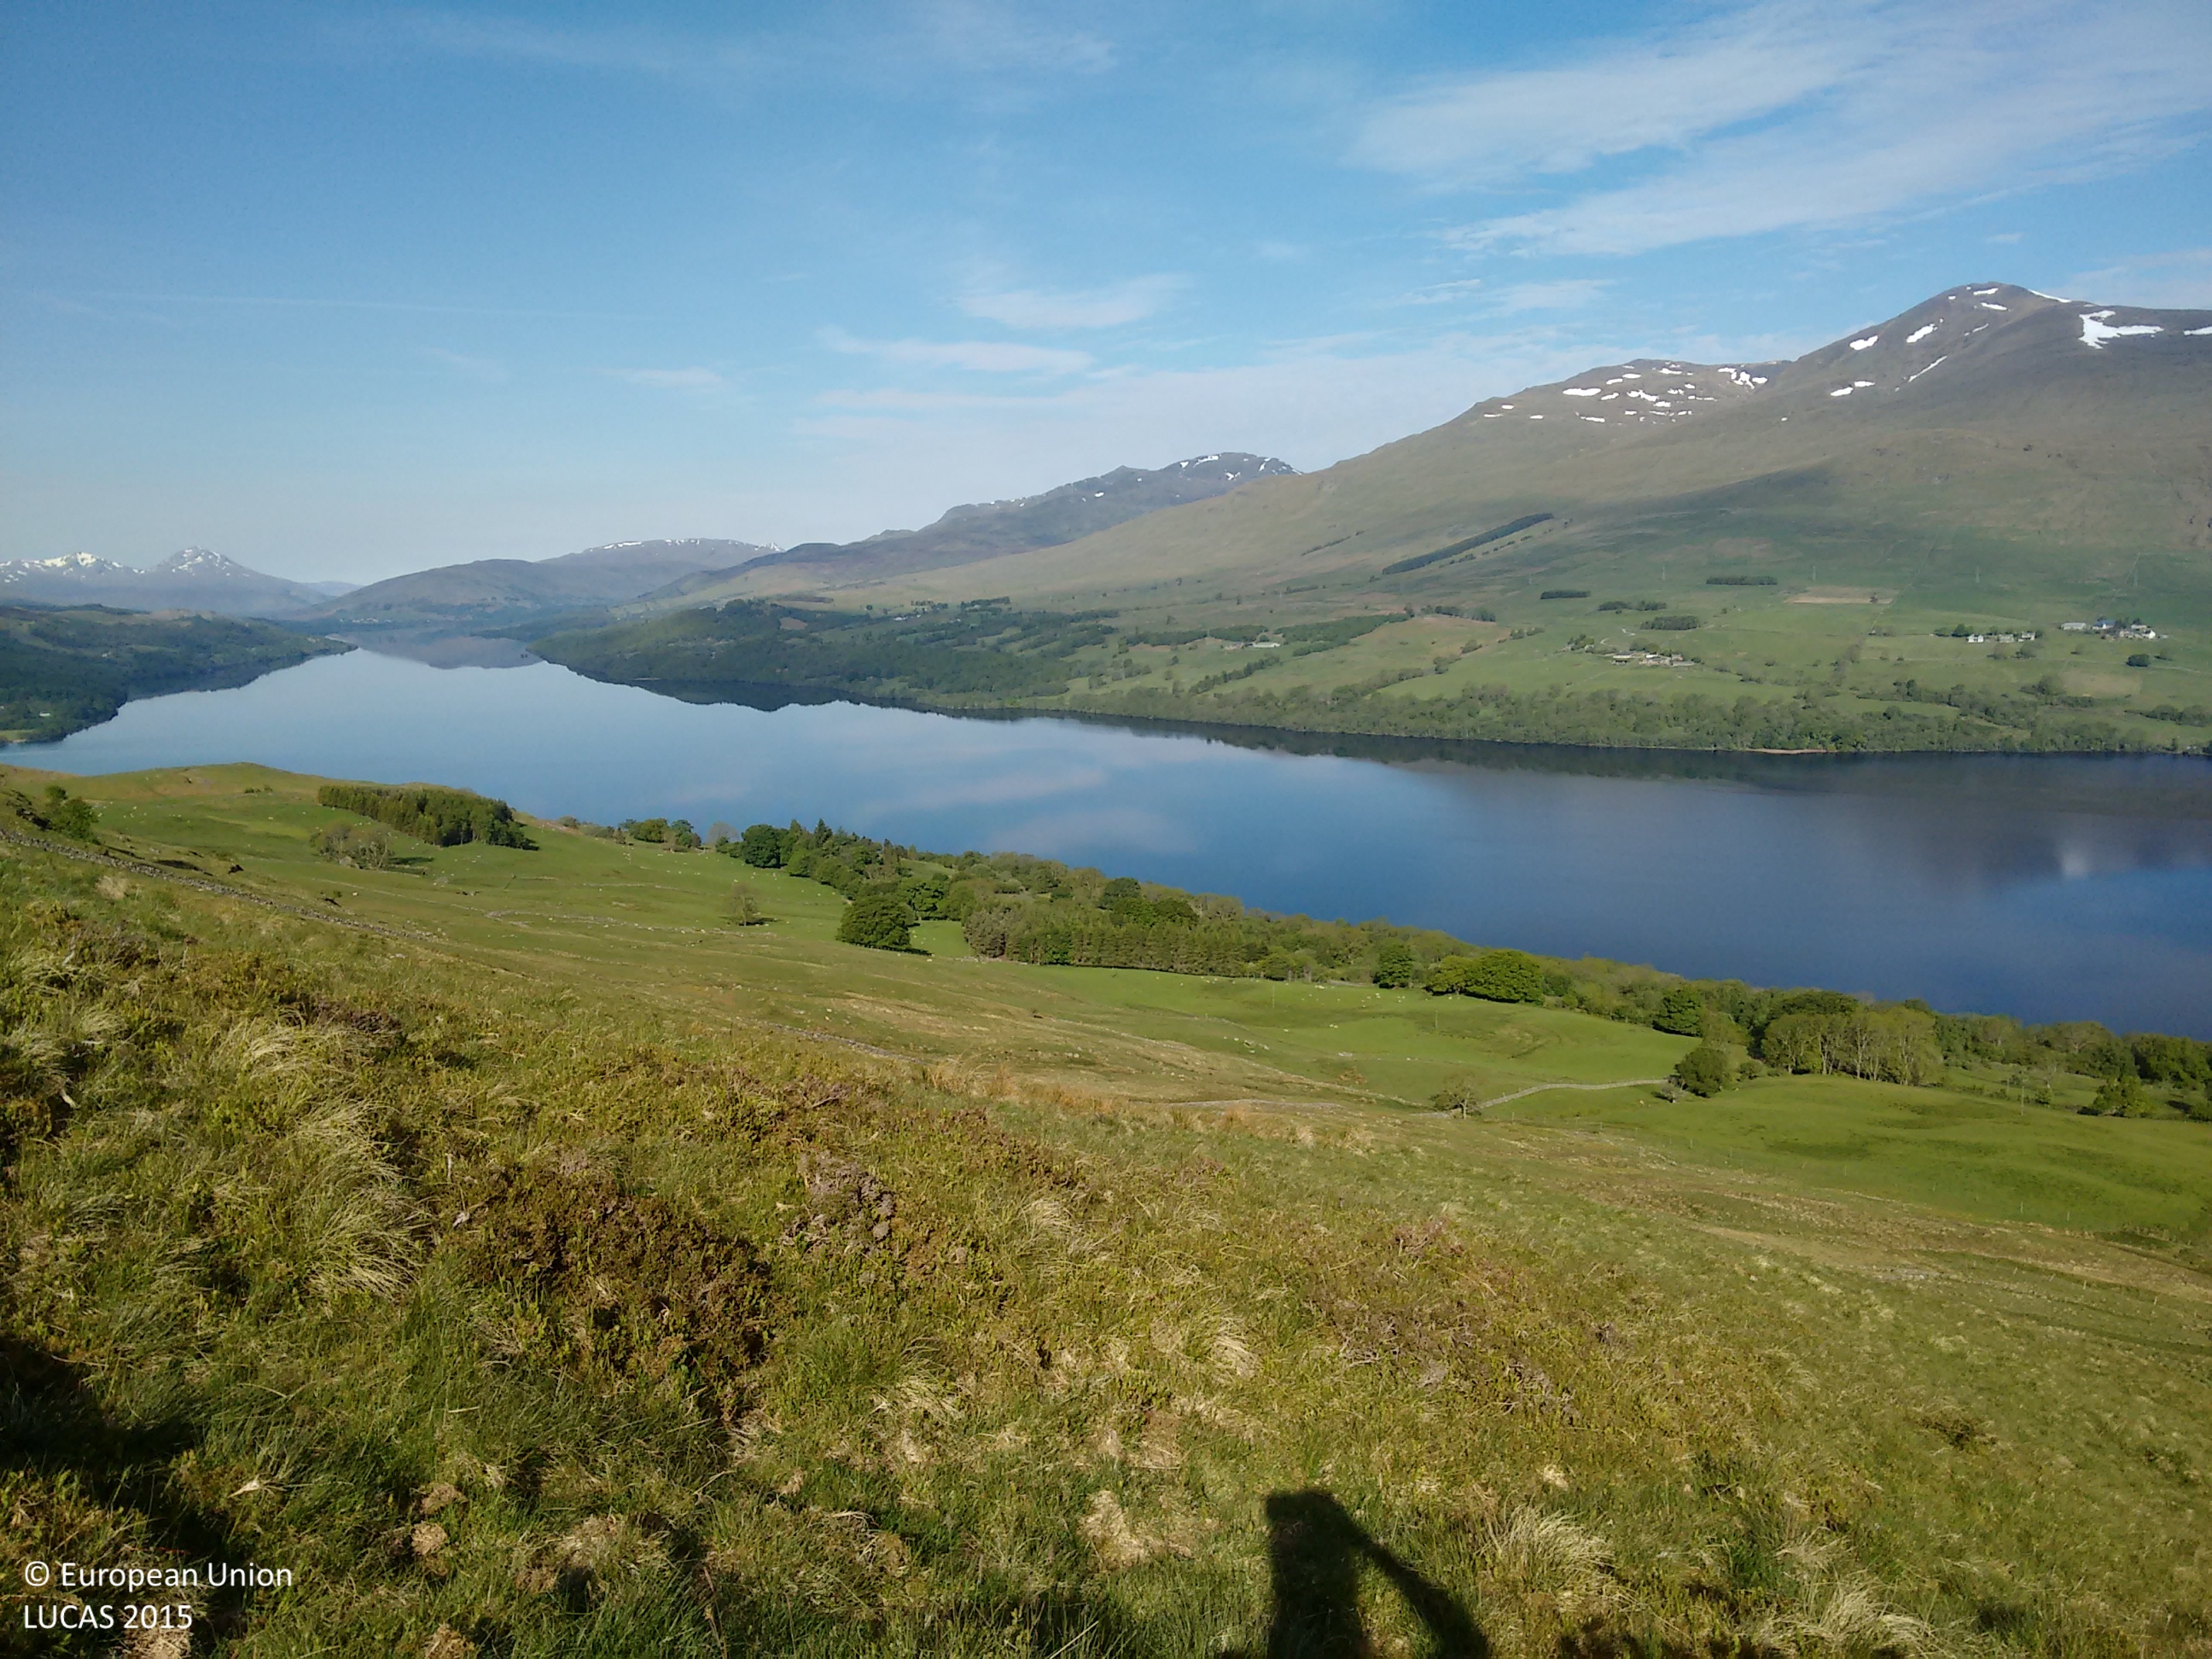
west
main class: Grassland
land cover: Grassland without tree/shrub cover
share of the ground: > 75 %
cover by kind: herbaceous plants 90 %, shrubs 5 %
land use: Agriculture (excluding fallow land and kitchen gardens)
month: June
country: GB
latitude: 56.5178
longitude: -4.1137
